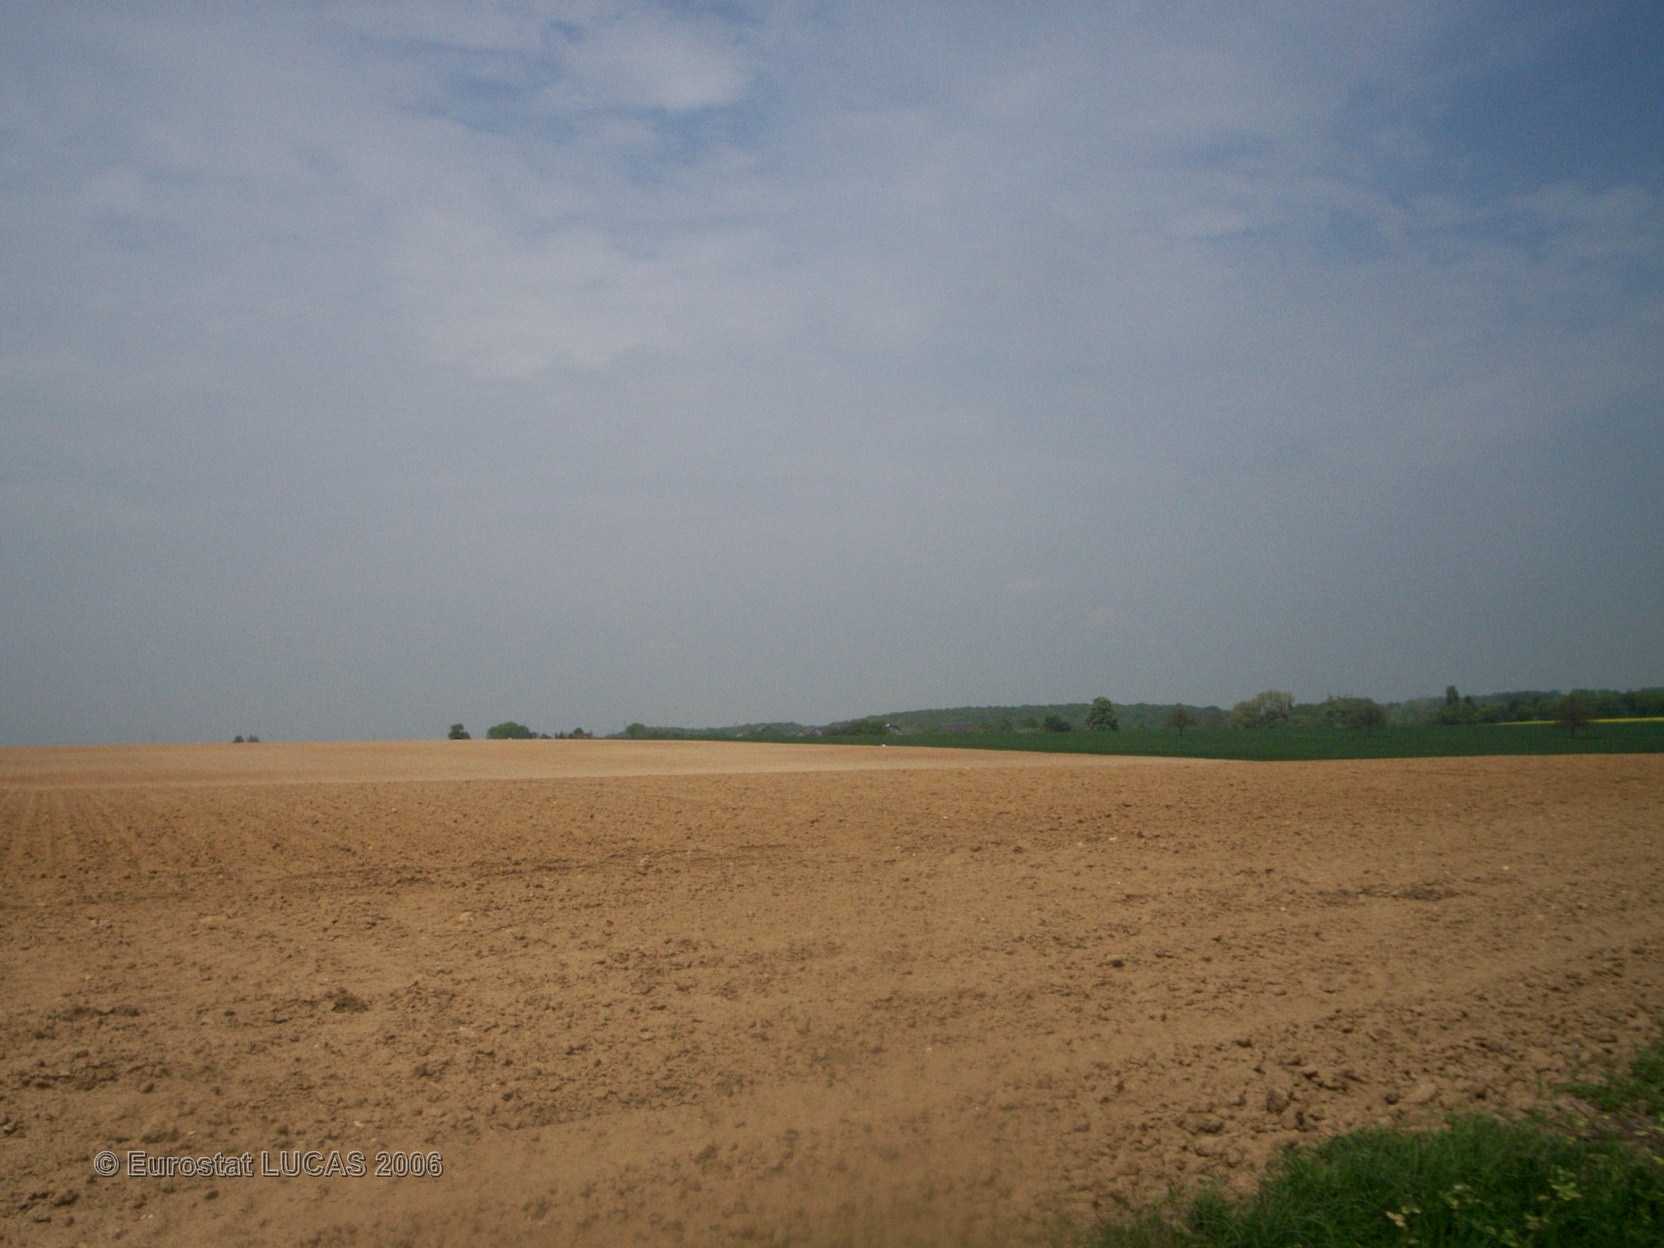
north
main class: Cropland
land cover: Sunflower
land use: Agriculture (excluding fallow land and kitchen gardens)
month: May
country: FR
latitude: 47.8890
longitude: 2.9449
